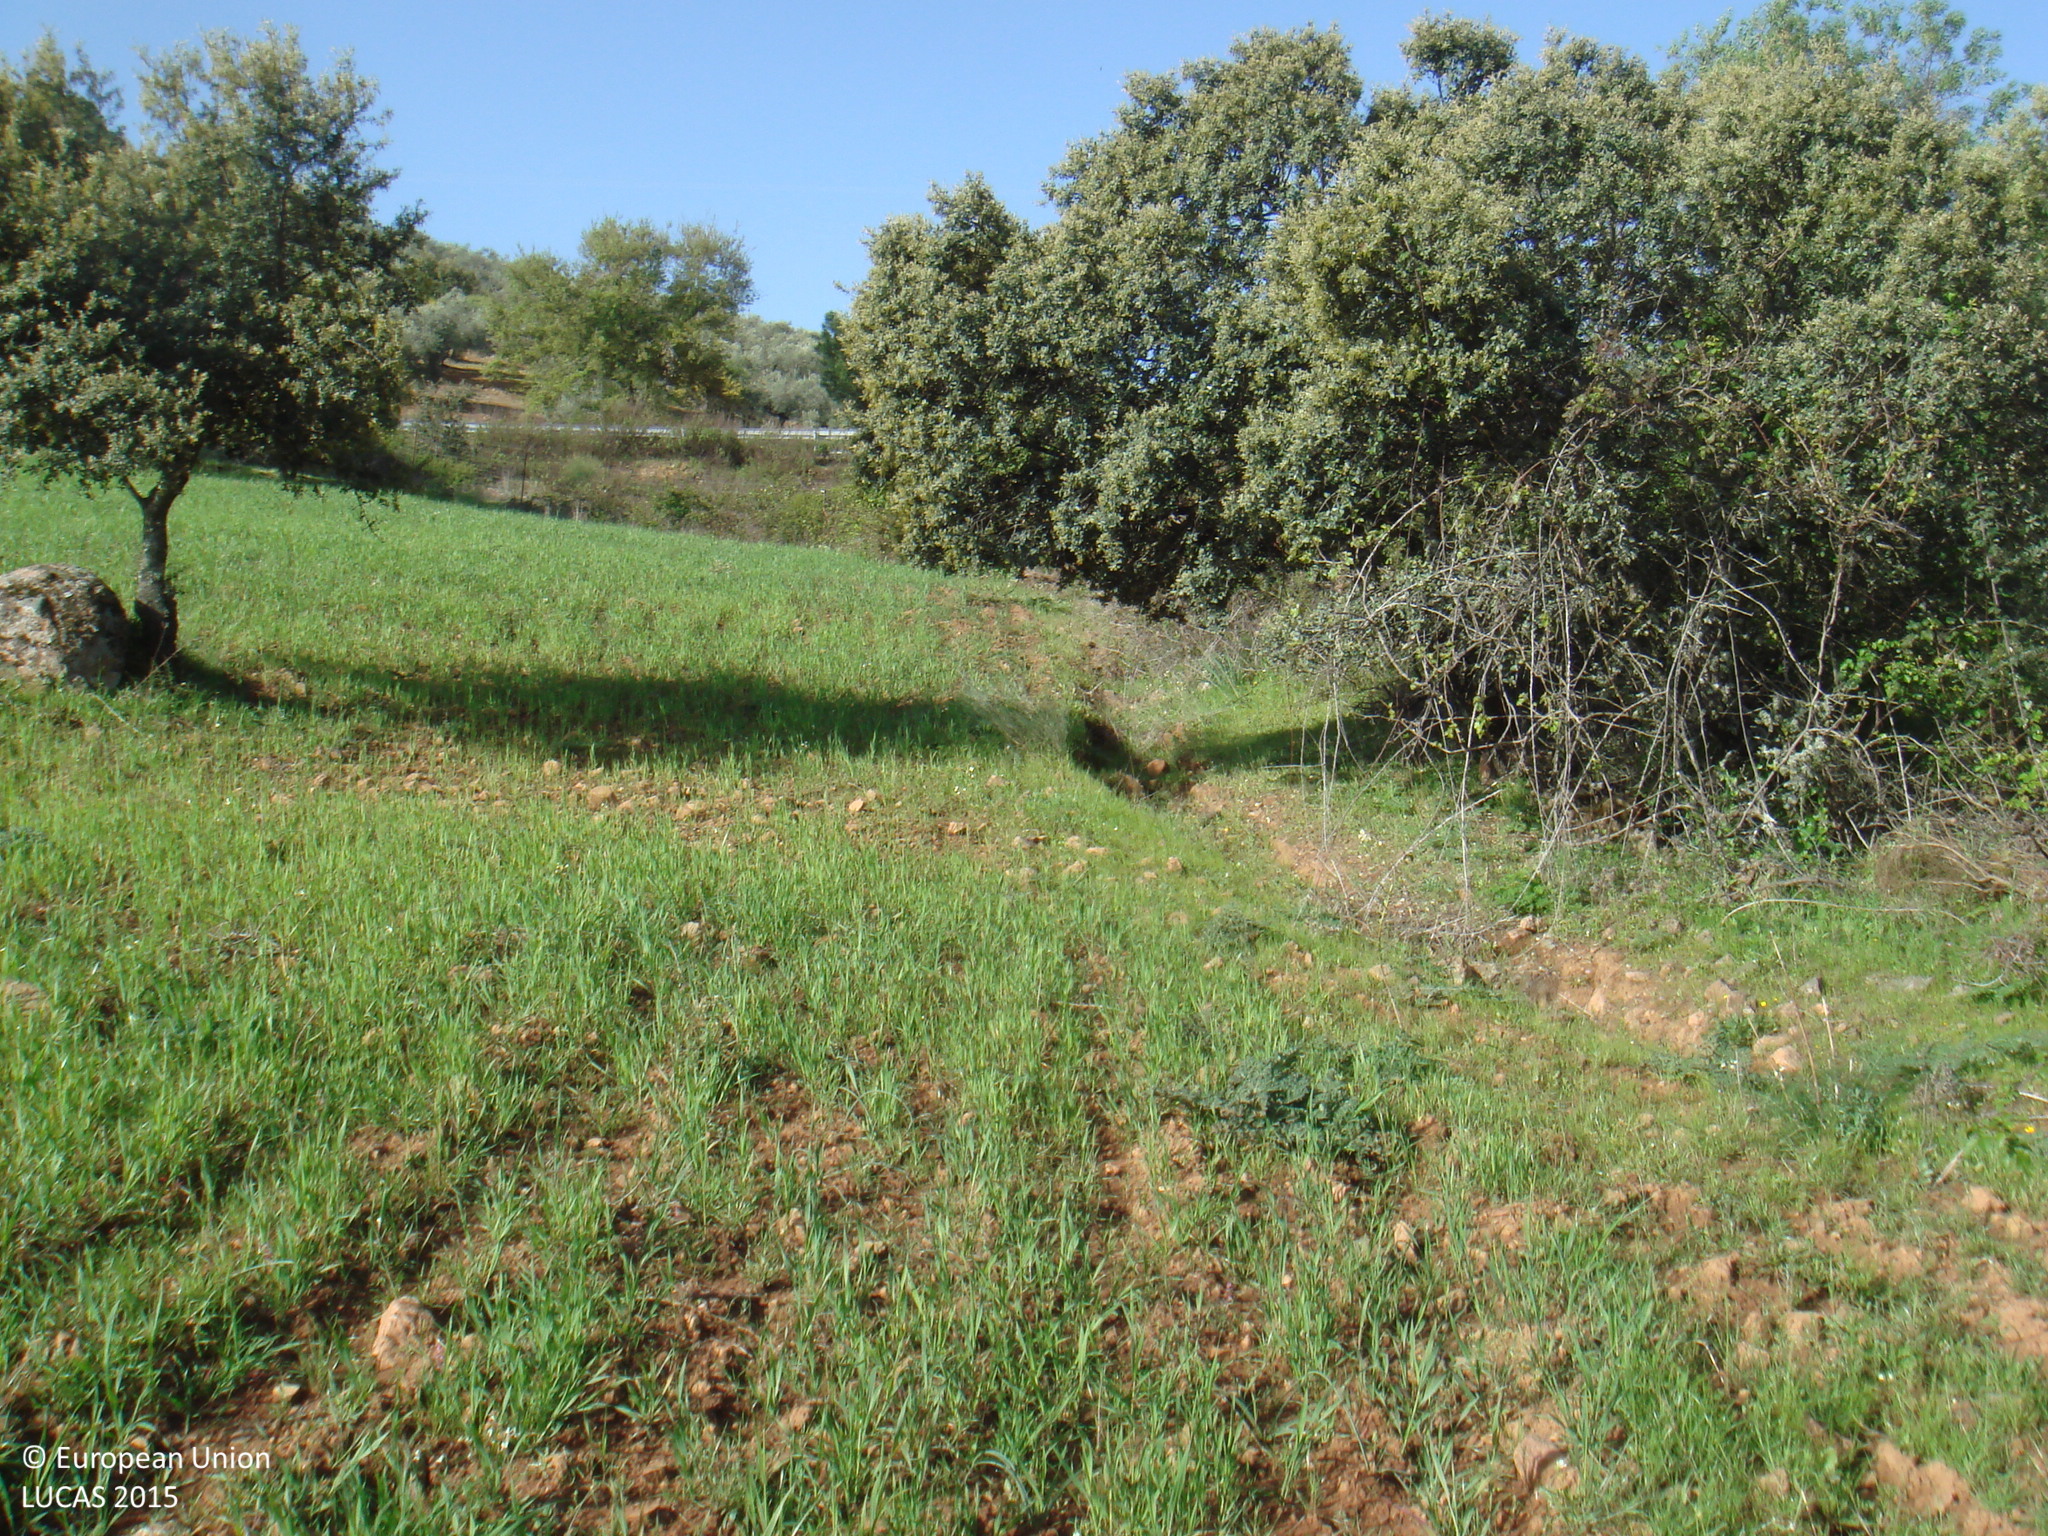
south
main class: Cropland
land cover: Oats
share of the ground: > 75 %
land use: Agriculture (excluding fallow land and kitchen gardens)
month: April
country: ES
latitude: 38.1042
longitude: -5.0641
